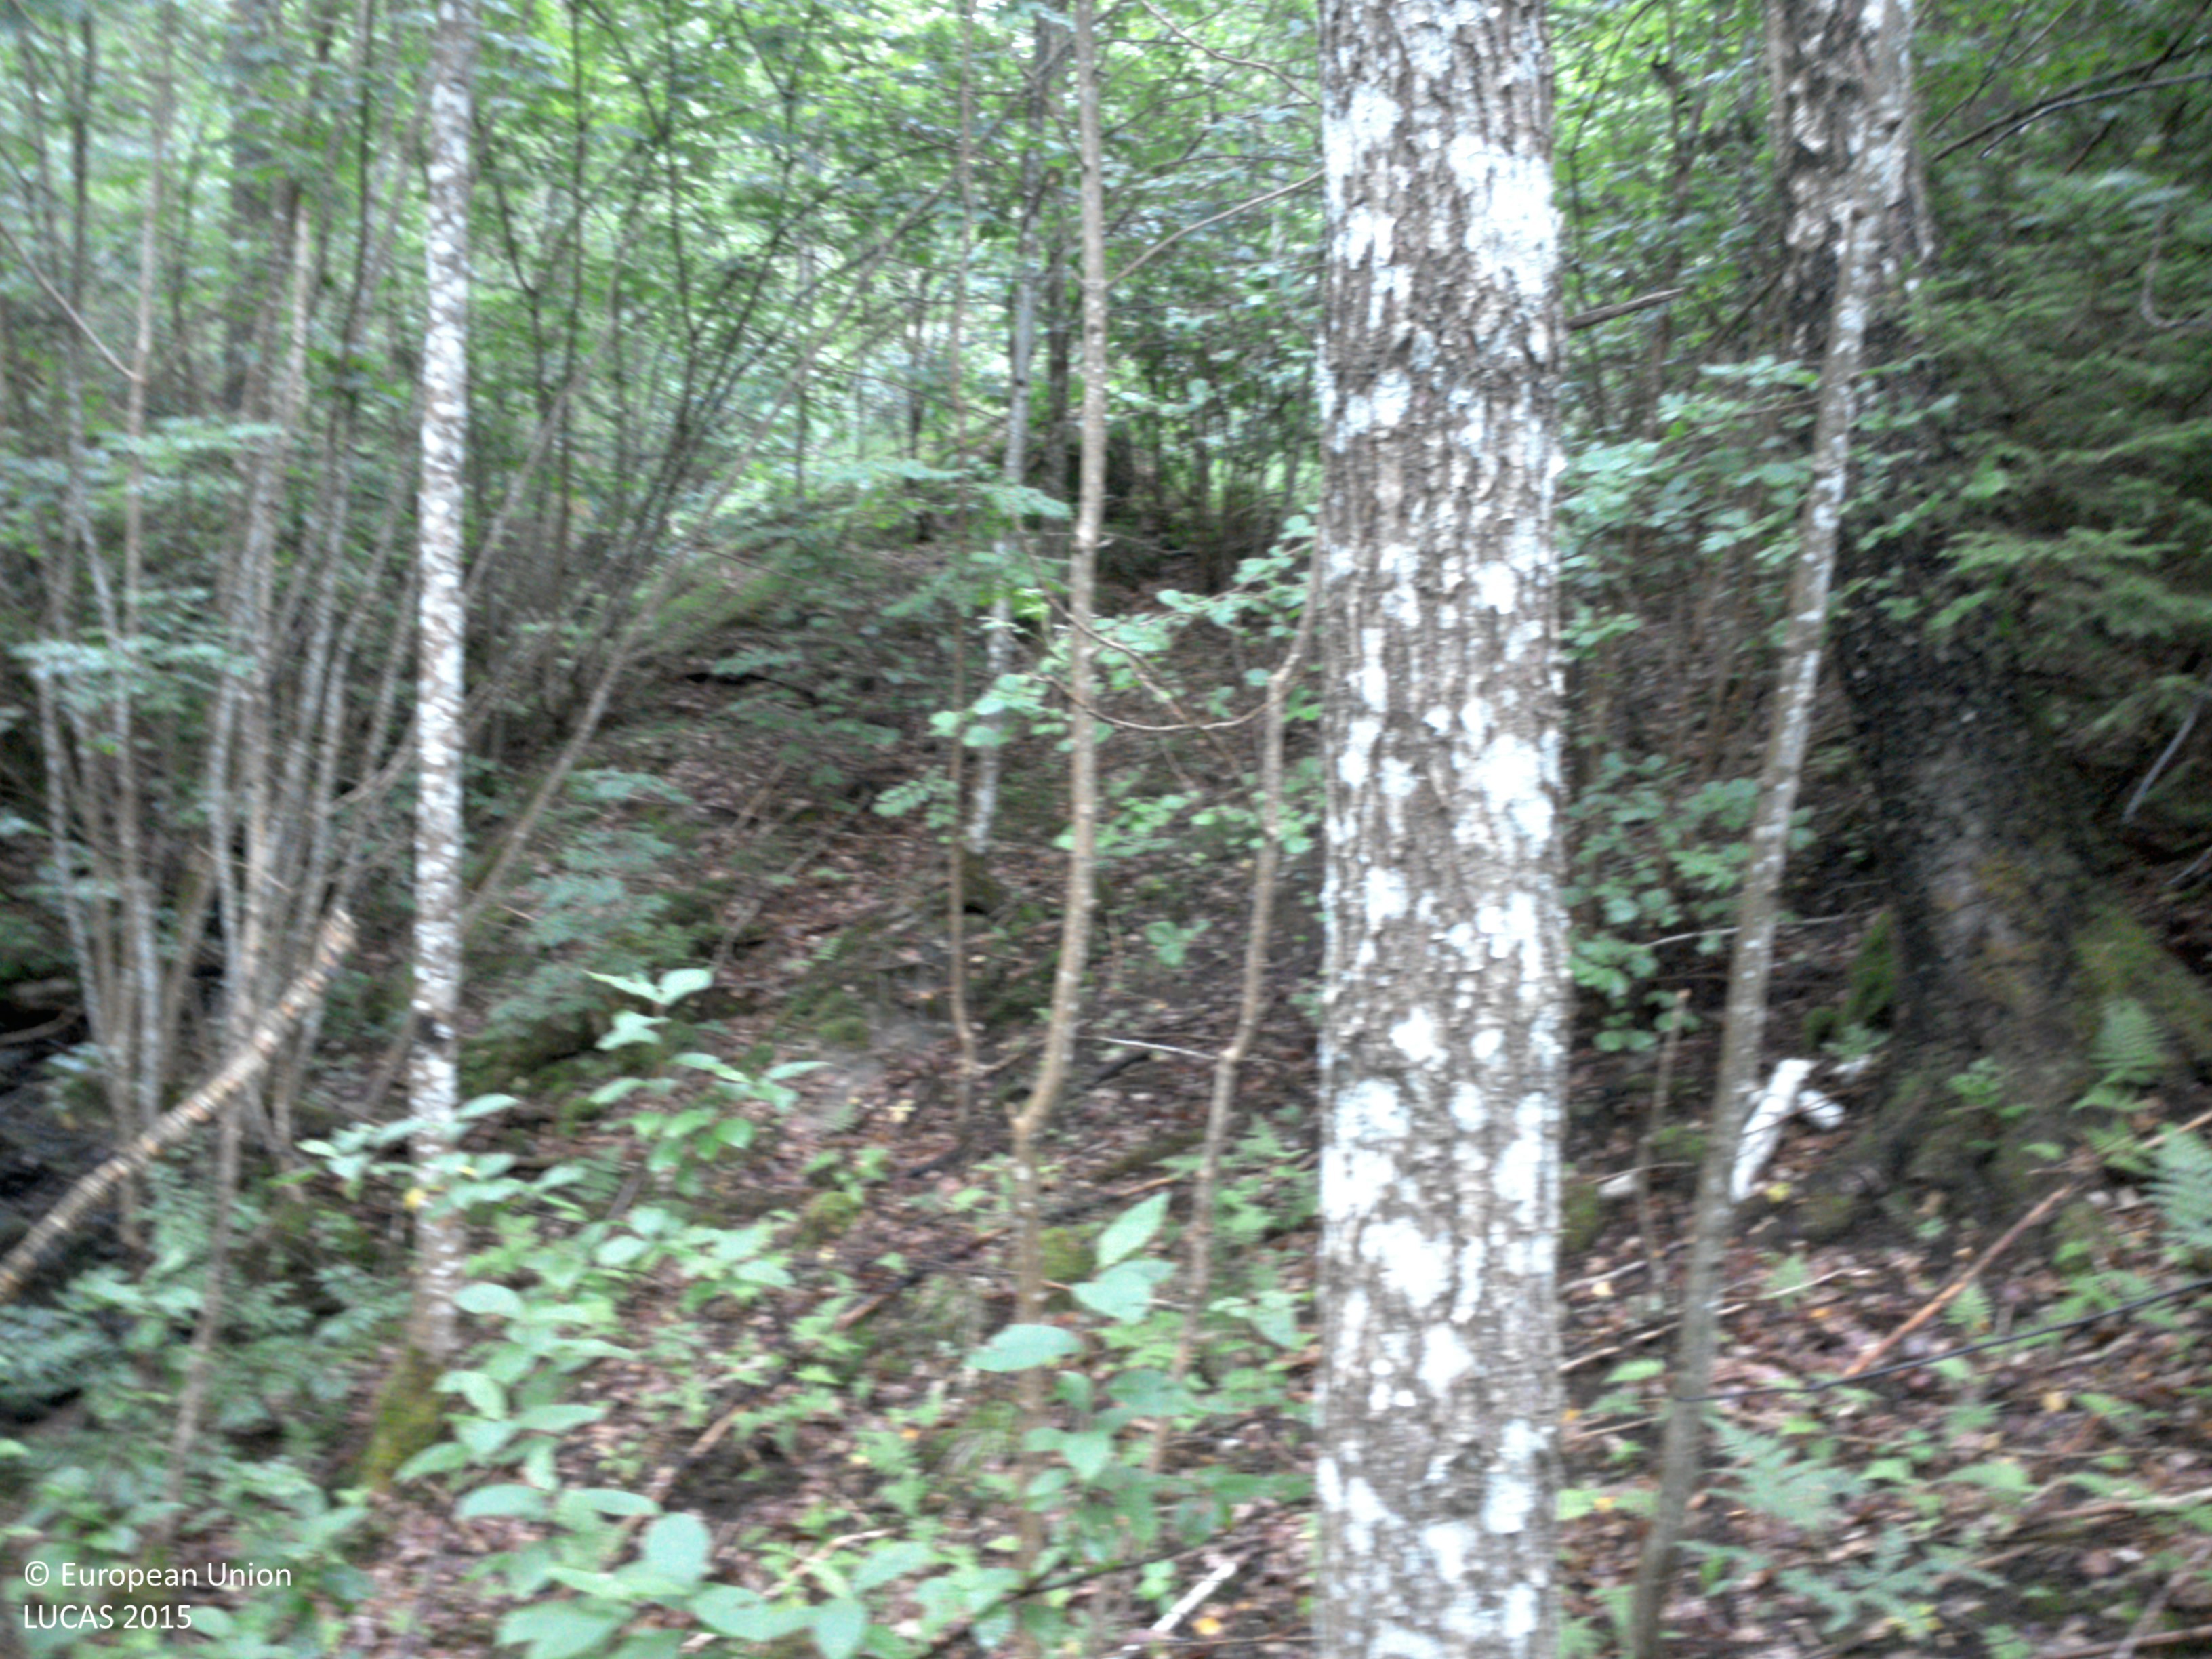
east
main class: Woodland
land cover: Broadleaved woodland
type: hemiboreal forest and nemoral coniferous forest and mixed broadleaved-coniferous forest
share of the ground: 50 - 75 %
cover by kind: broadleaved forest trees 75 %, herbaceous plants 25 %
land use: Semi-natural and natural areas not in use
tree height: > 5 m
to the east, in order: Broadleaved woodland; Rivers and streams; Broadleaved woodland; Ditches and canals; Grass margins; Paved roads, cycling and walking lanes; Grass margins; Ditches and canals; Abandoned hedges; Grassland without tree/shrub cover; Ditches and canals; Electric lines; Broadleaved woodland
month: July
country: SE
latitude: 58.6742
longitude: 11.8756
